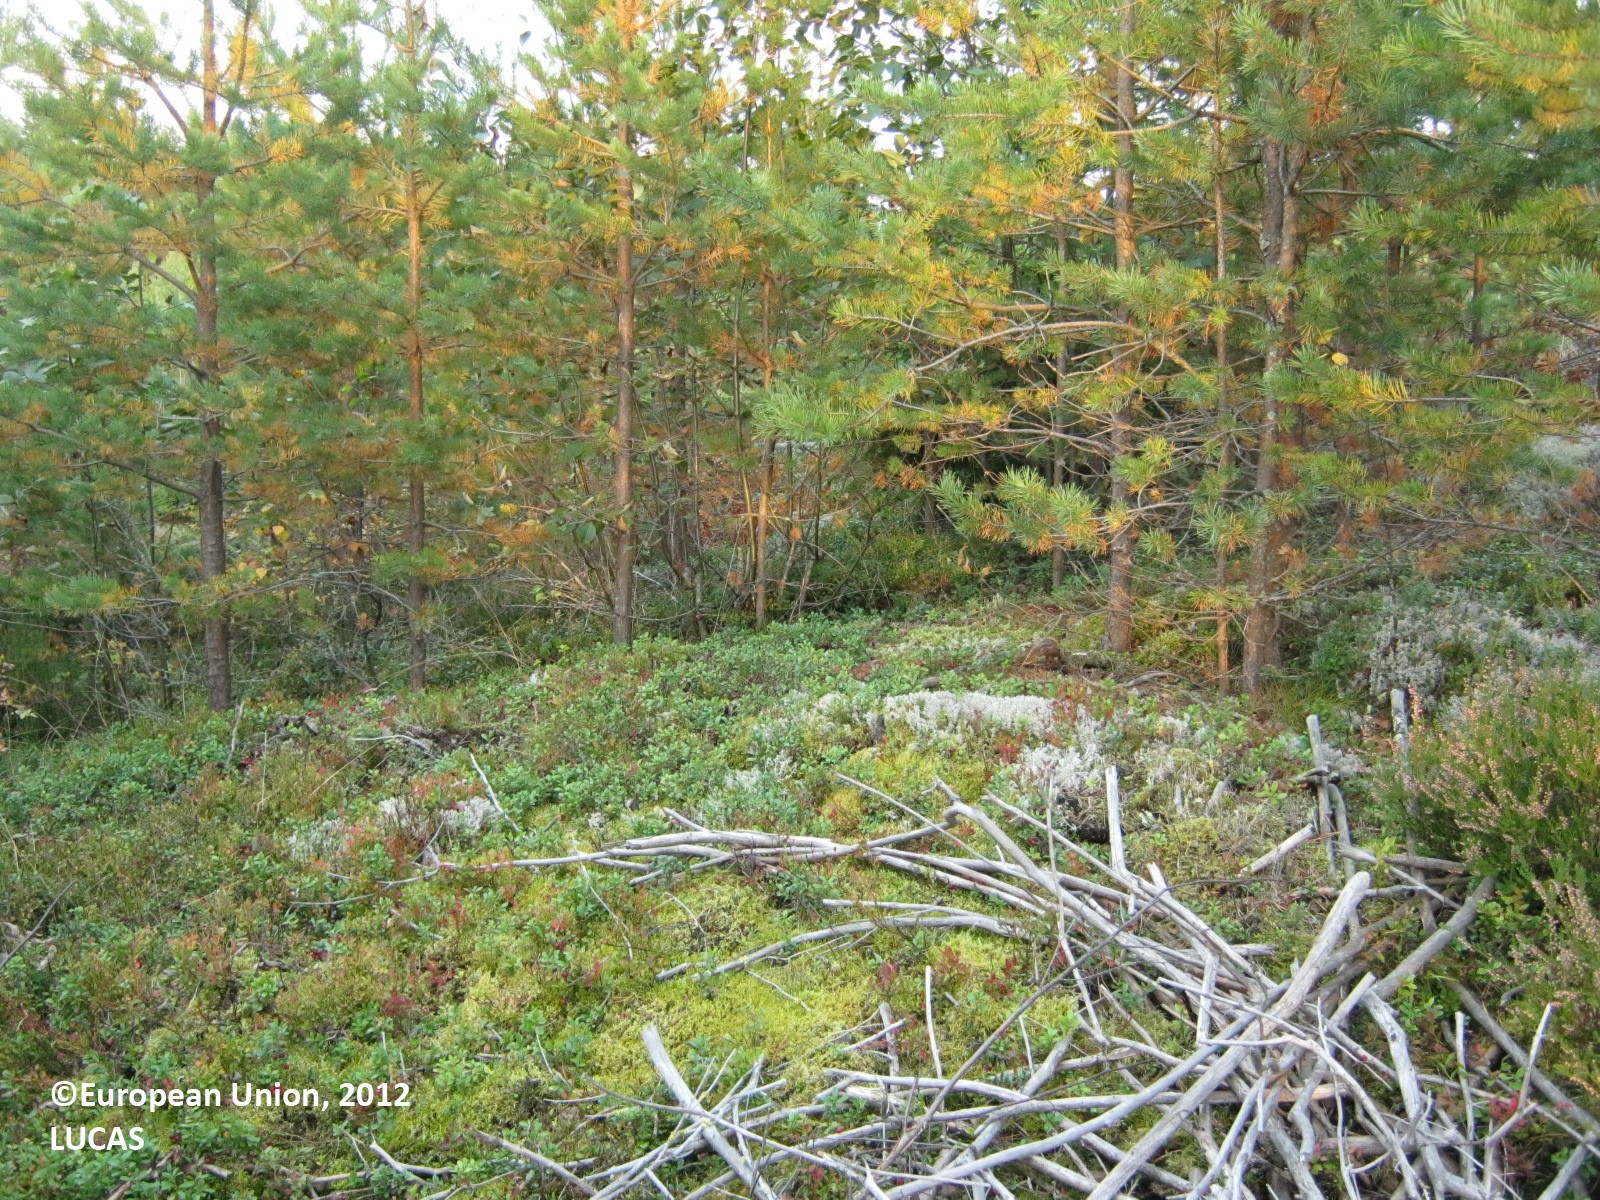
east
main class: Woodland
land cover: Pine dominated coniferous woodland
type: boreal forest
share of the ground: > 75 %
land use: Forestry
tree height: < 5 m
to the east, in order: Pine dominated coniferous woodland; Tracks; Pine dominated coniferous woodland; Spruce dominated coniferous woodland; Shrubland with sparse tree cover; Spruce dominated coniferous woodland; Ditches and canals; Spruce dominated coniferous woodland
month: September
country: FI
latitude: 60.8488
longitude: 27.9583
